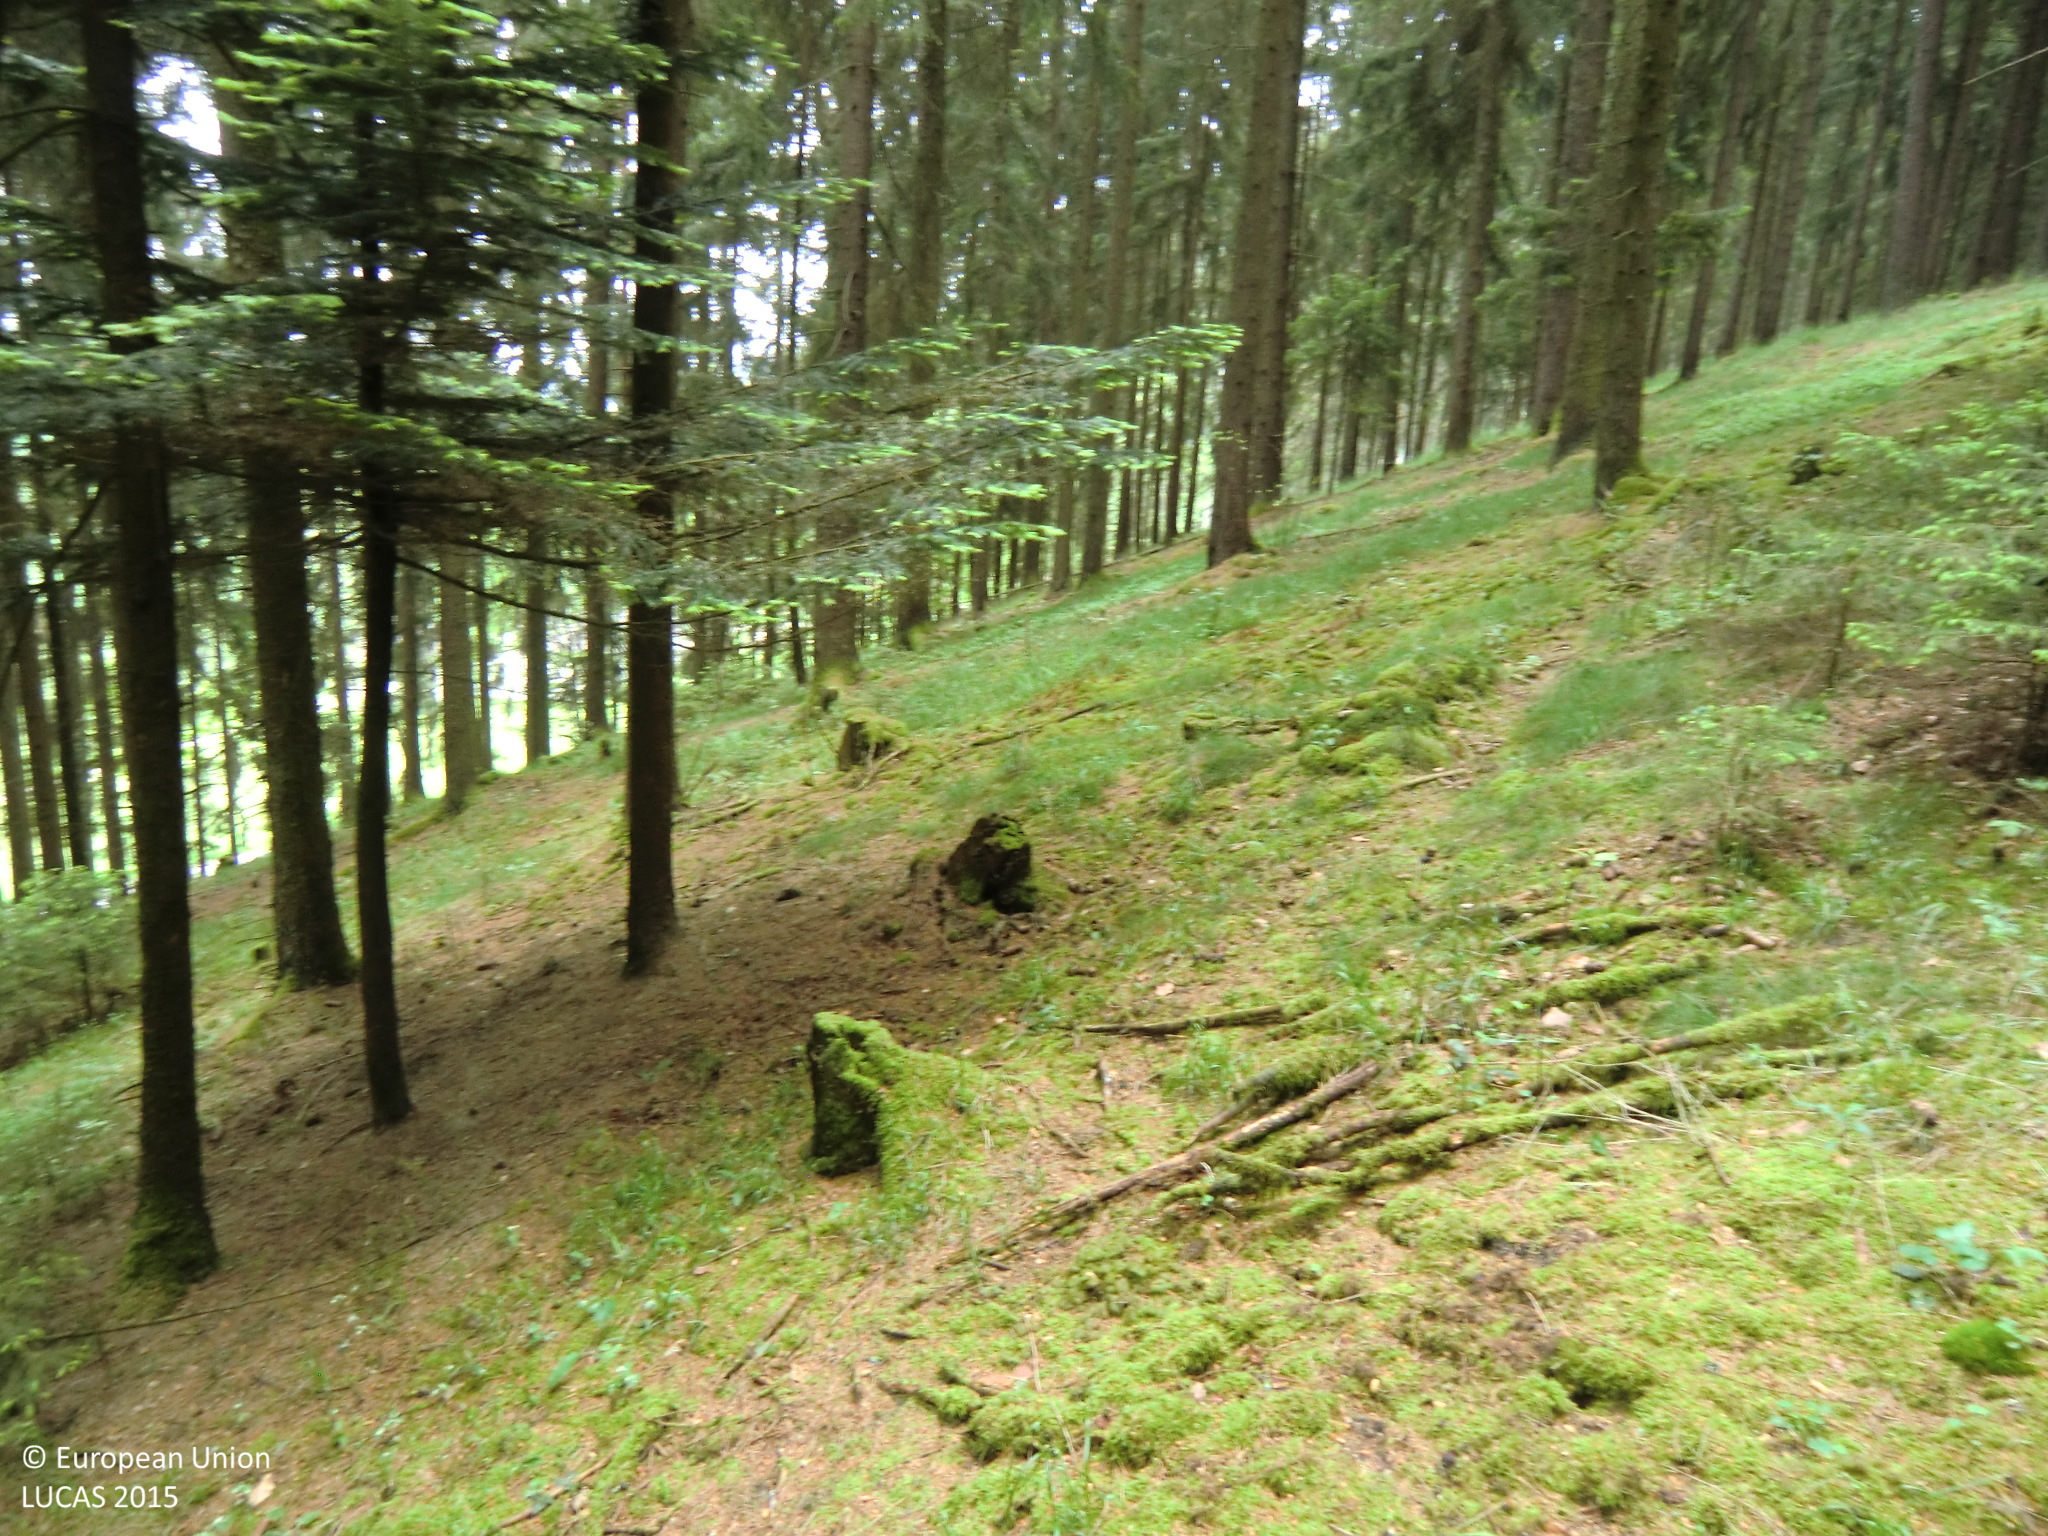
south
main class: Woodland
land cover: Spruce dominated coniferous woodland
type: alpine coniferous forest
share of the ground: > 75 %
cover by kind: coniferous forest trees 65 %, lichens and mosses 25 %, consolidated bare surface 10 %
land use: Forestry
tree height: > 5 m
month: May
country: AT
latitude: 48.4064
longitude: 14.3908
